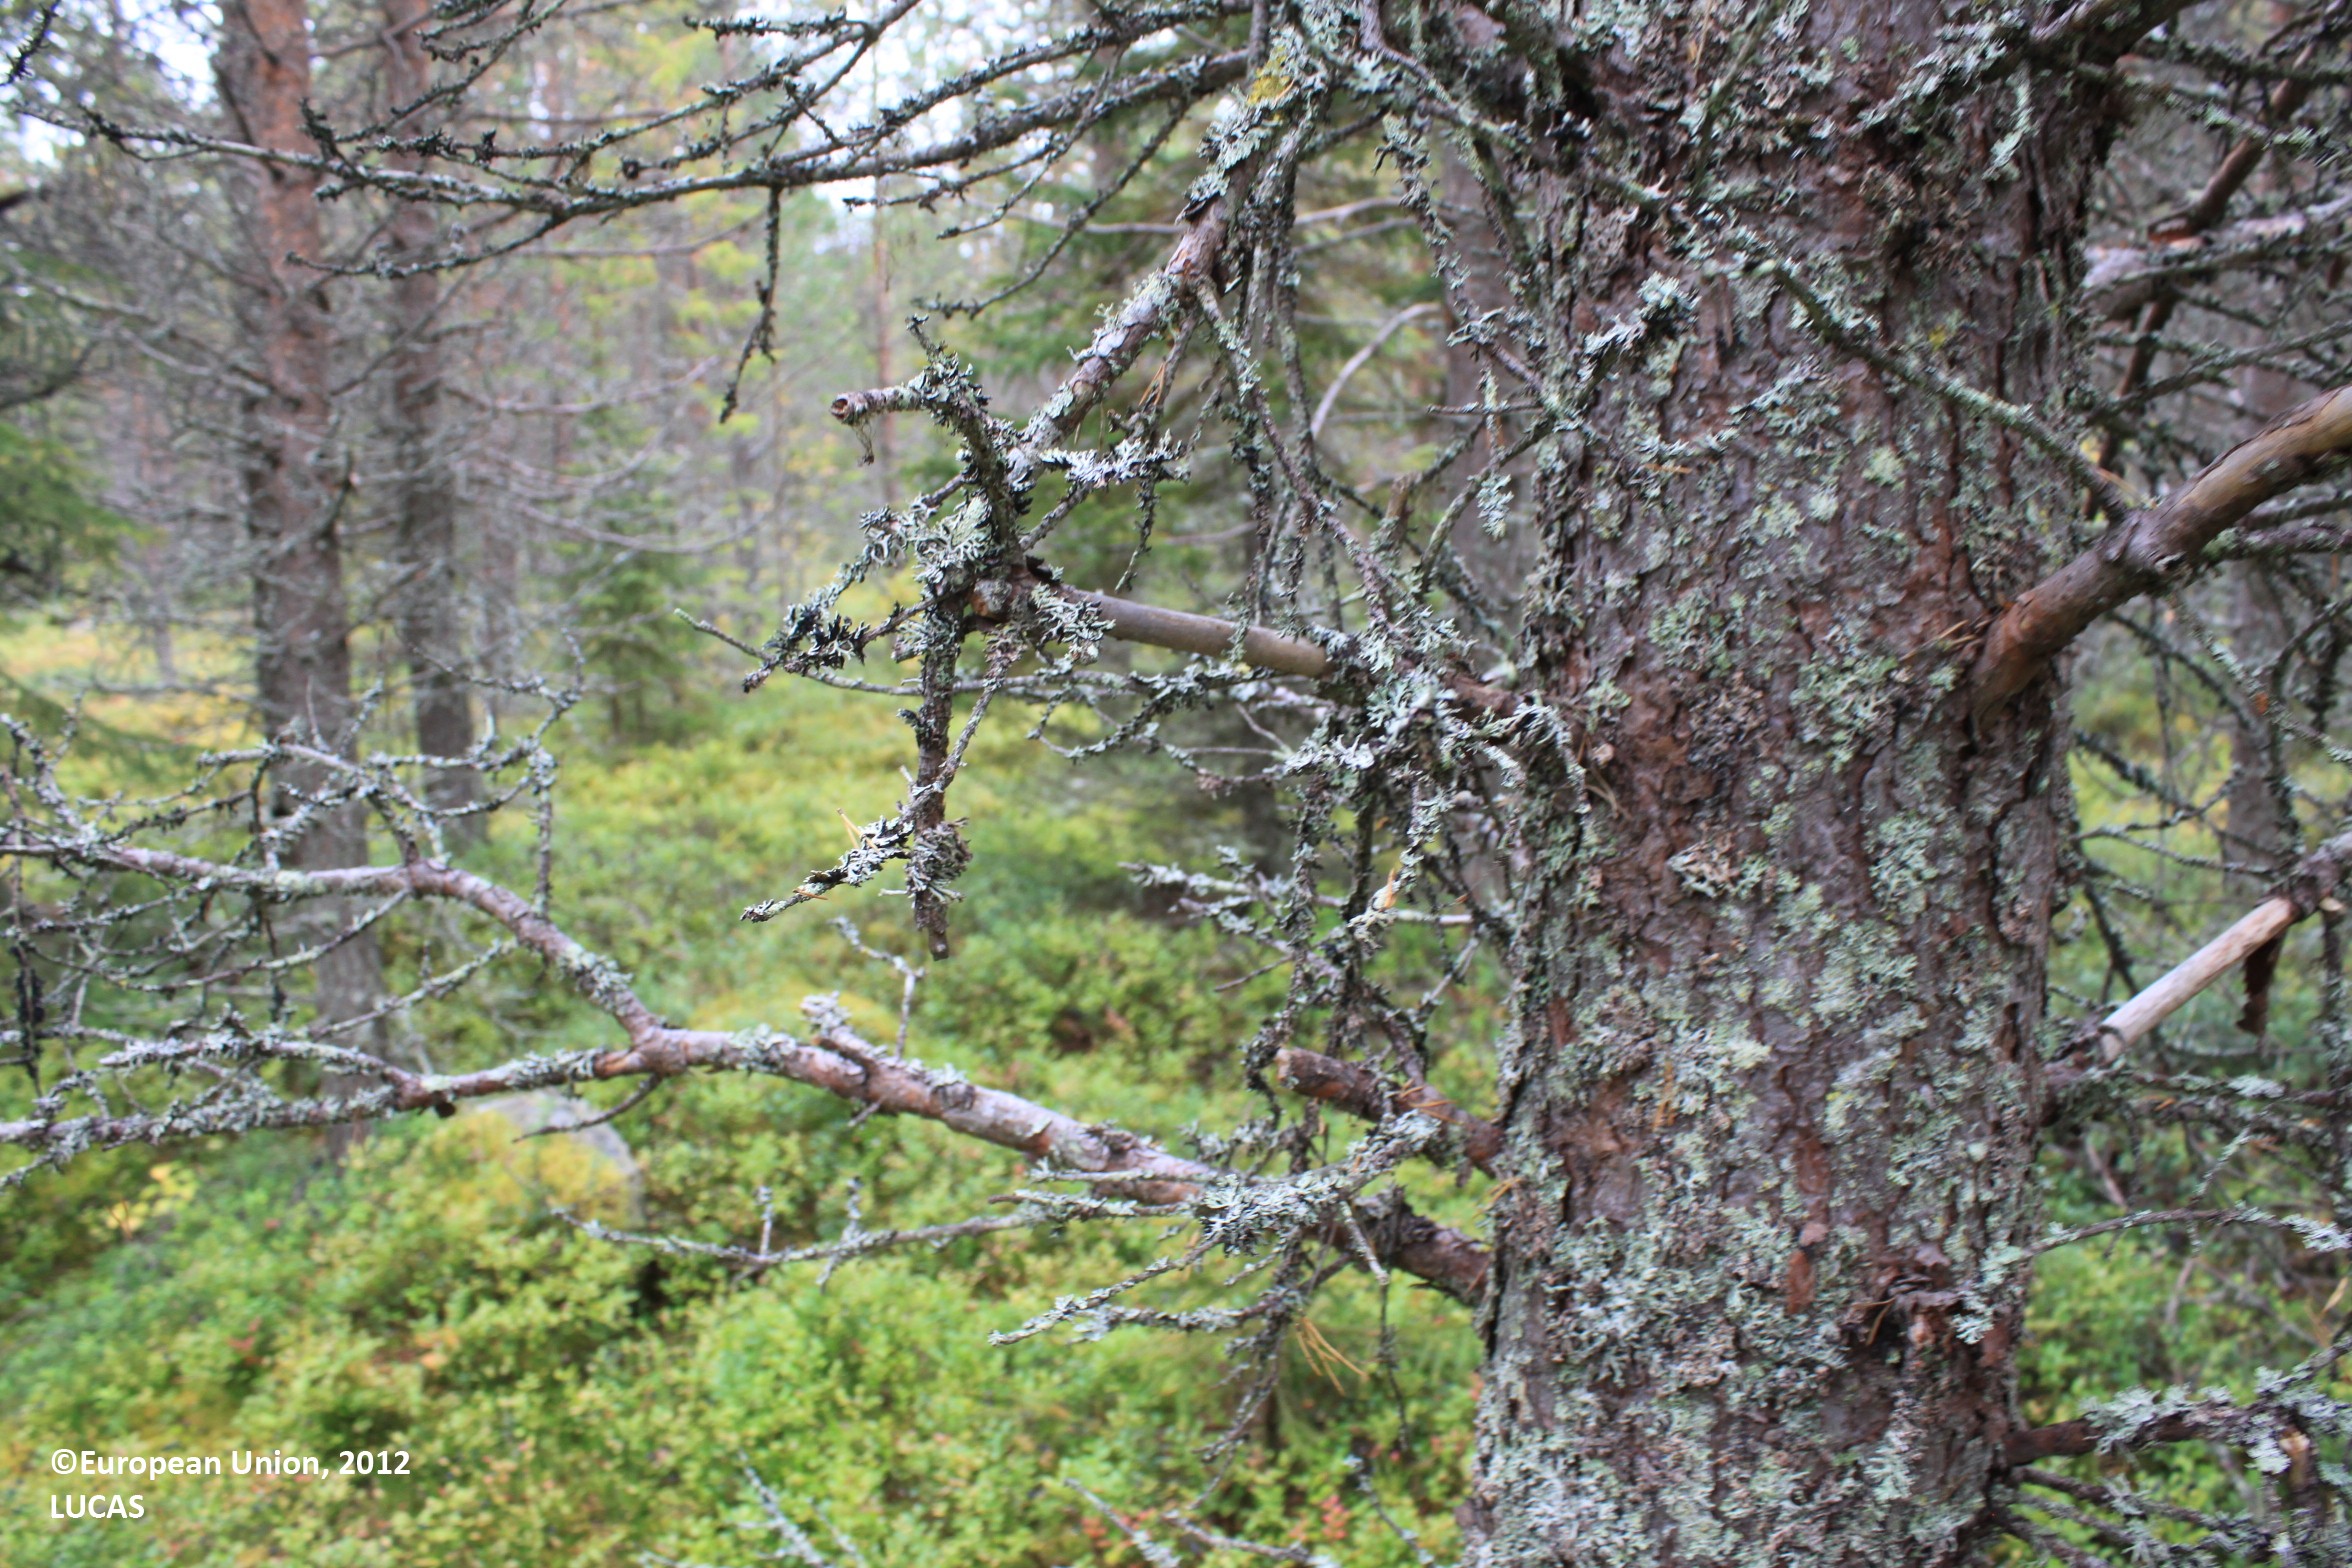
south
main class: Woodland
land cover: Pine dominated coniferous woodland
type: boreal forest
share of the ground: 25 - 50 %
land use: Forestry
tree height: > 5 m
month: September
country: FI
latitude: 65.8892
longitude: 27.3404
